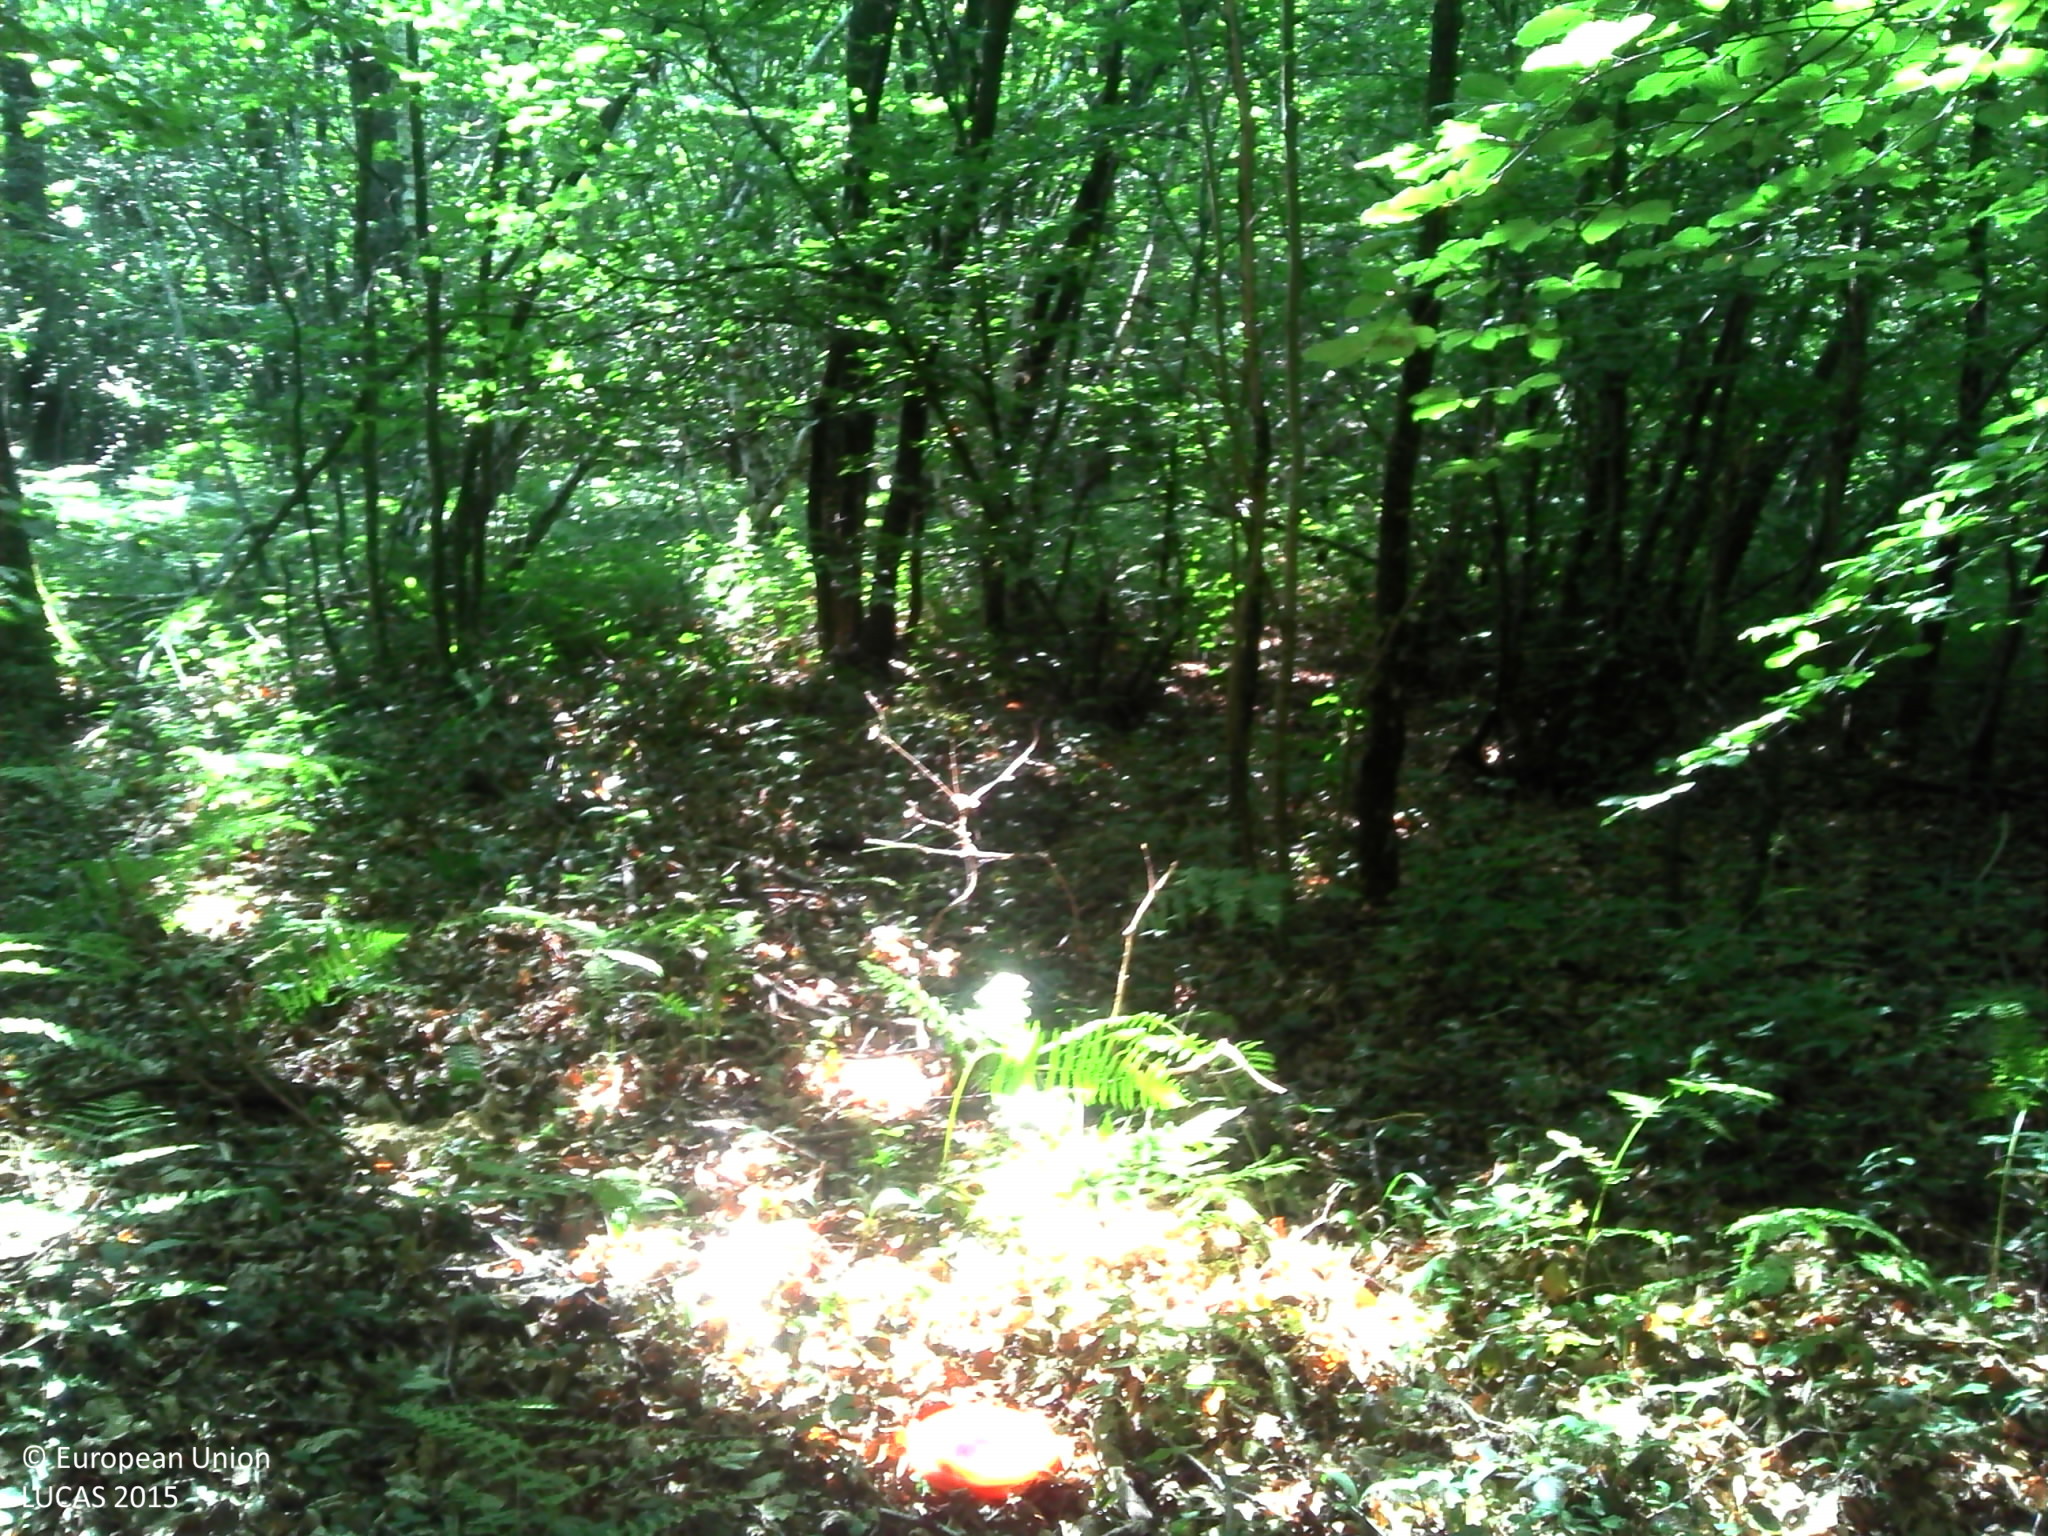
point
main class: Woodland
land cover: Broadleaved woodland
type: beech forest
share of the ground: > 75 %
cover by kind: broadleaved forest trees 90 %, herbaceous plants 5 %, consolidated bare surface 5 %
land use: Forestry
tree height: > 5 m
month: July
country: FR
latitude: 45.4284
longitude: 5.1349
